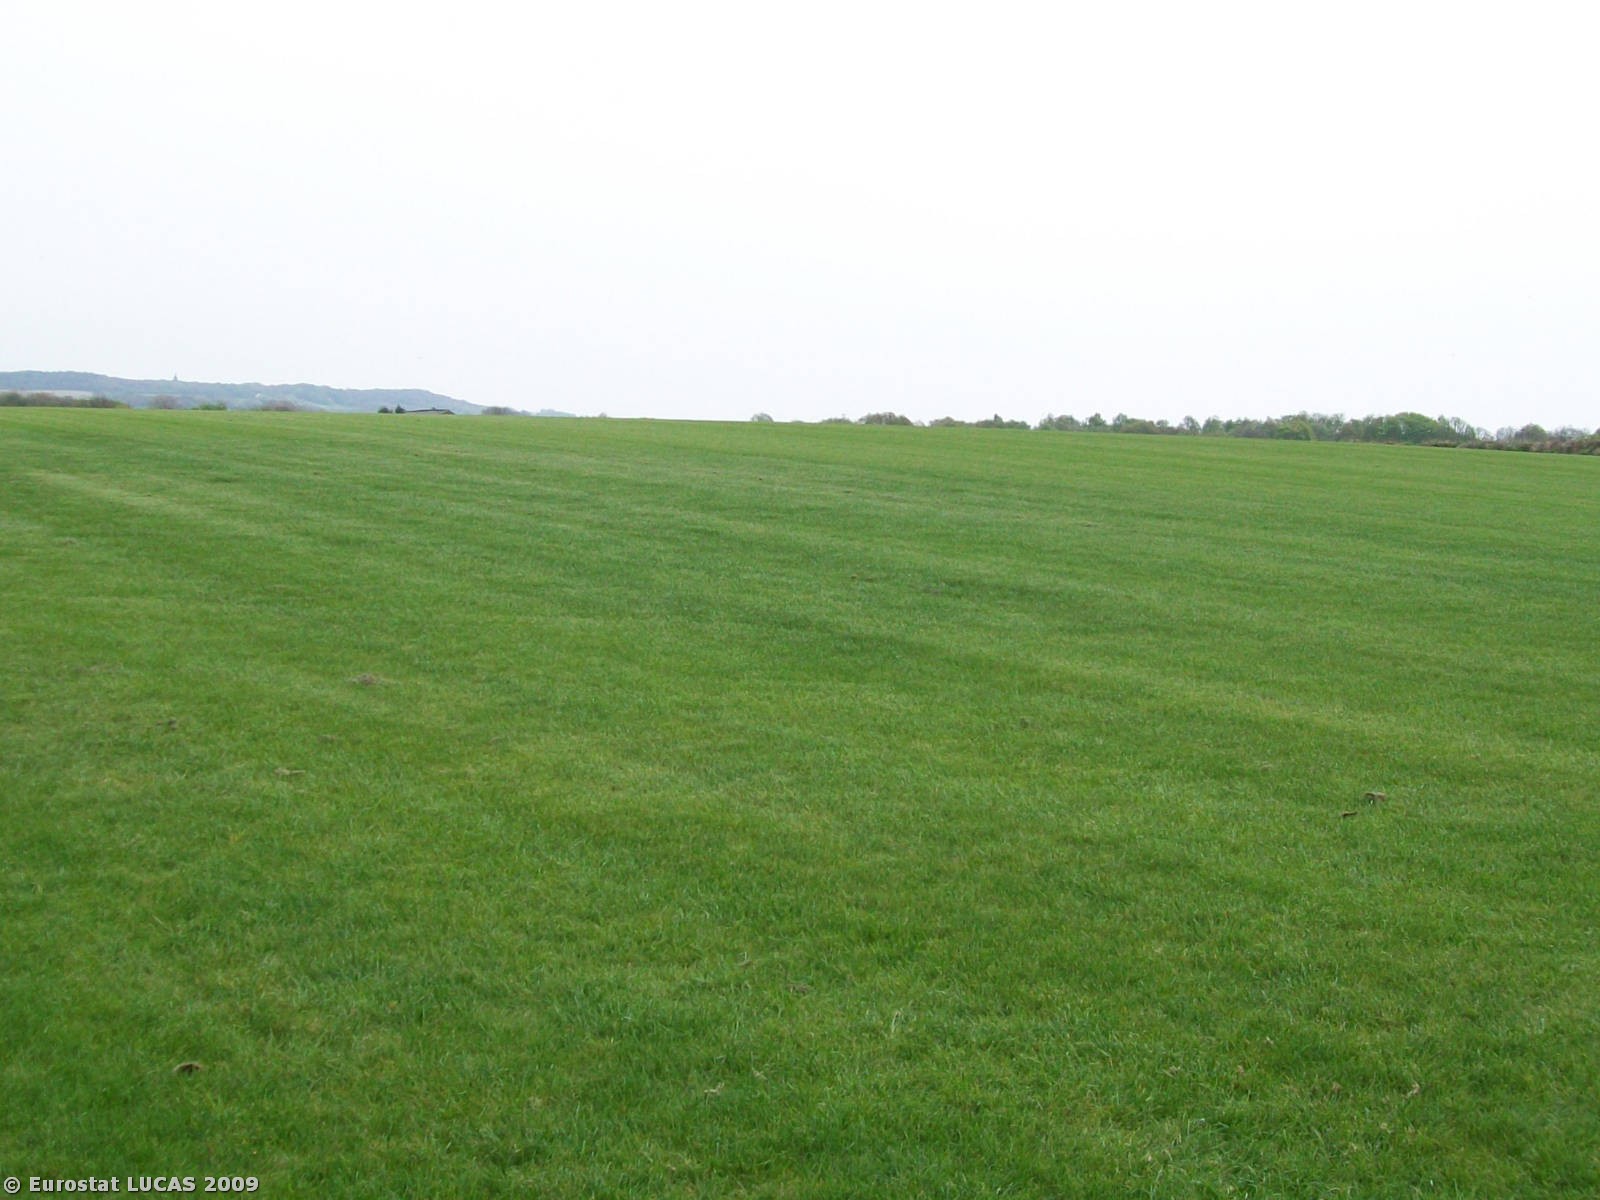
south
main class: Grassland
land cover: Grassland without tree/shrub cover
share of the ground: 50 - 75 %
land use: Agriculture (excluding fallow land and kitchen gardens)
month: April
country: GB
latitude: 53.5750
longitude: -2.8017
